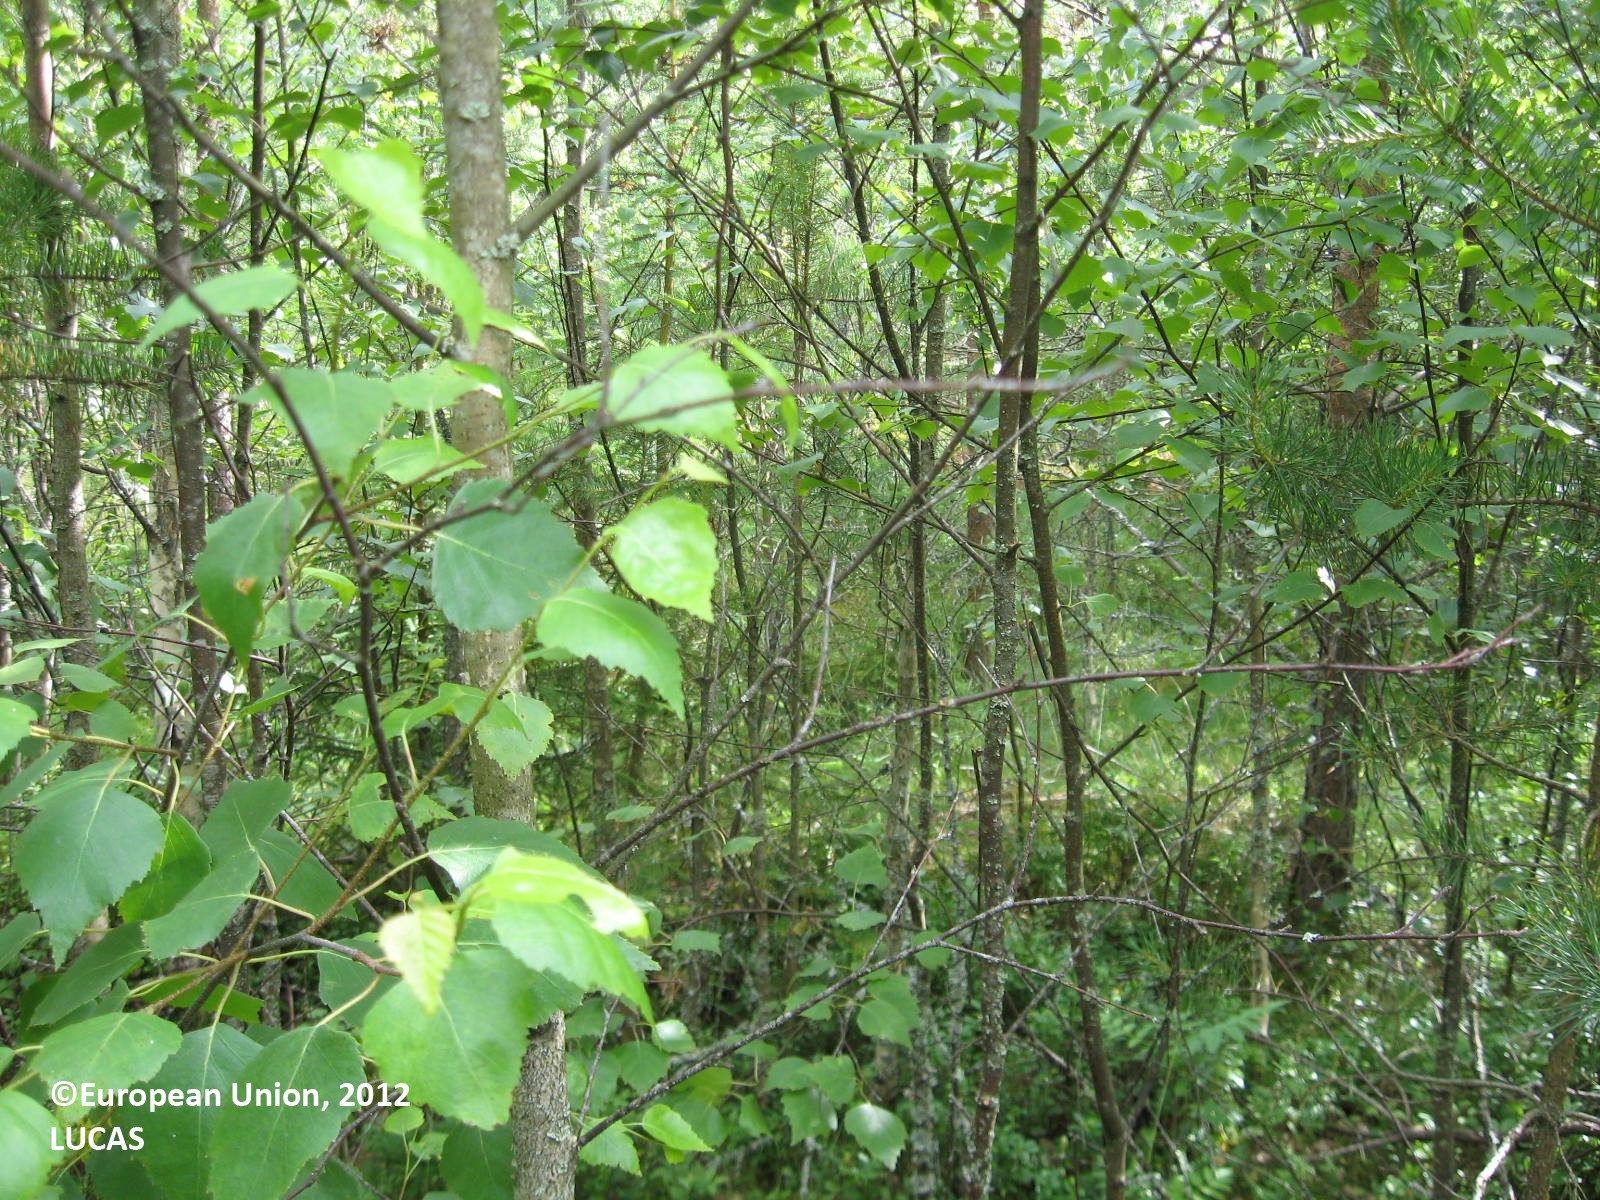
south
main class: Woodland
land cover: Other mixed woodland
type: boreal forest
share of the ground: > 75 %
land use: Forestry
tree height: > 5 m
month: July
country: FI
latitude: 62.5036
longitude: 21.4392
